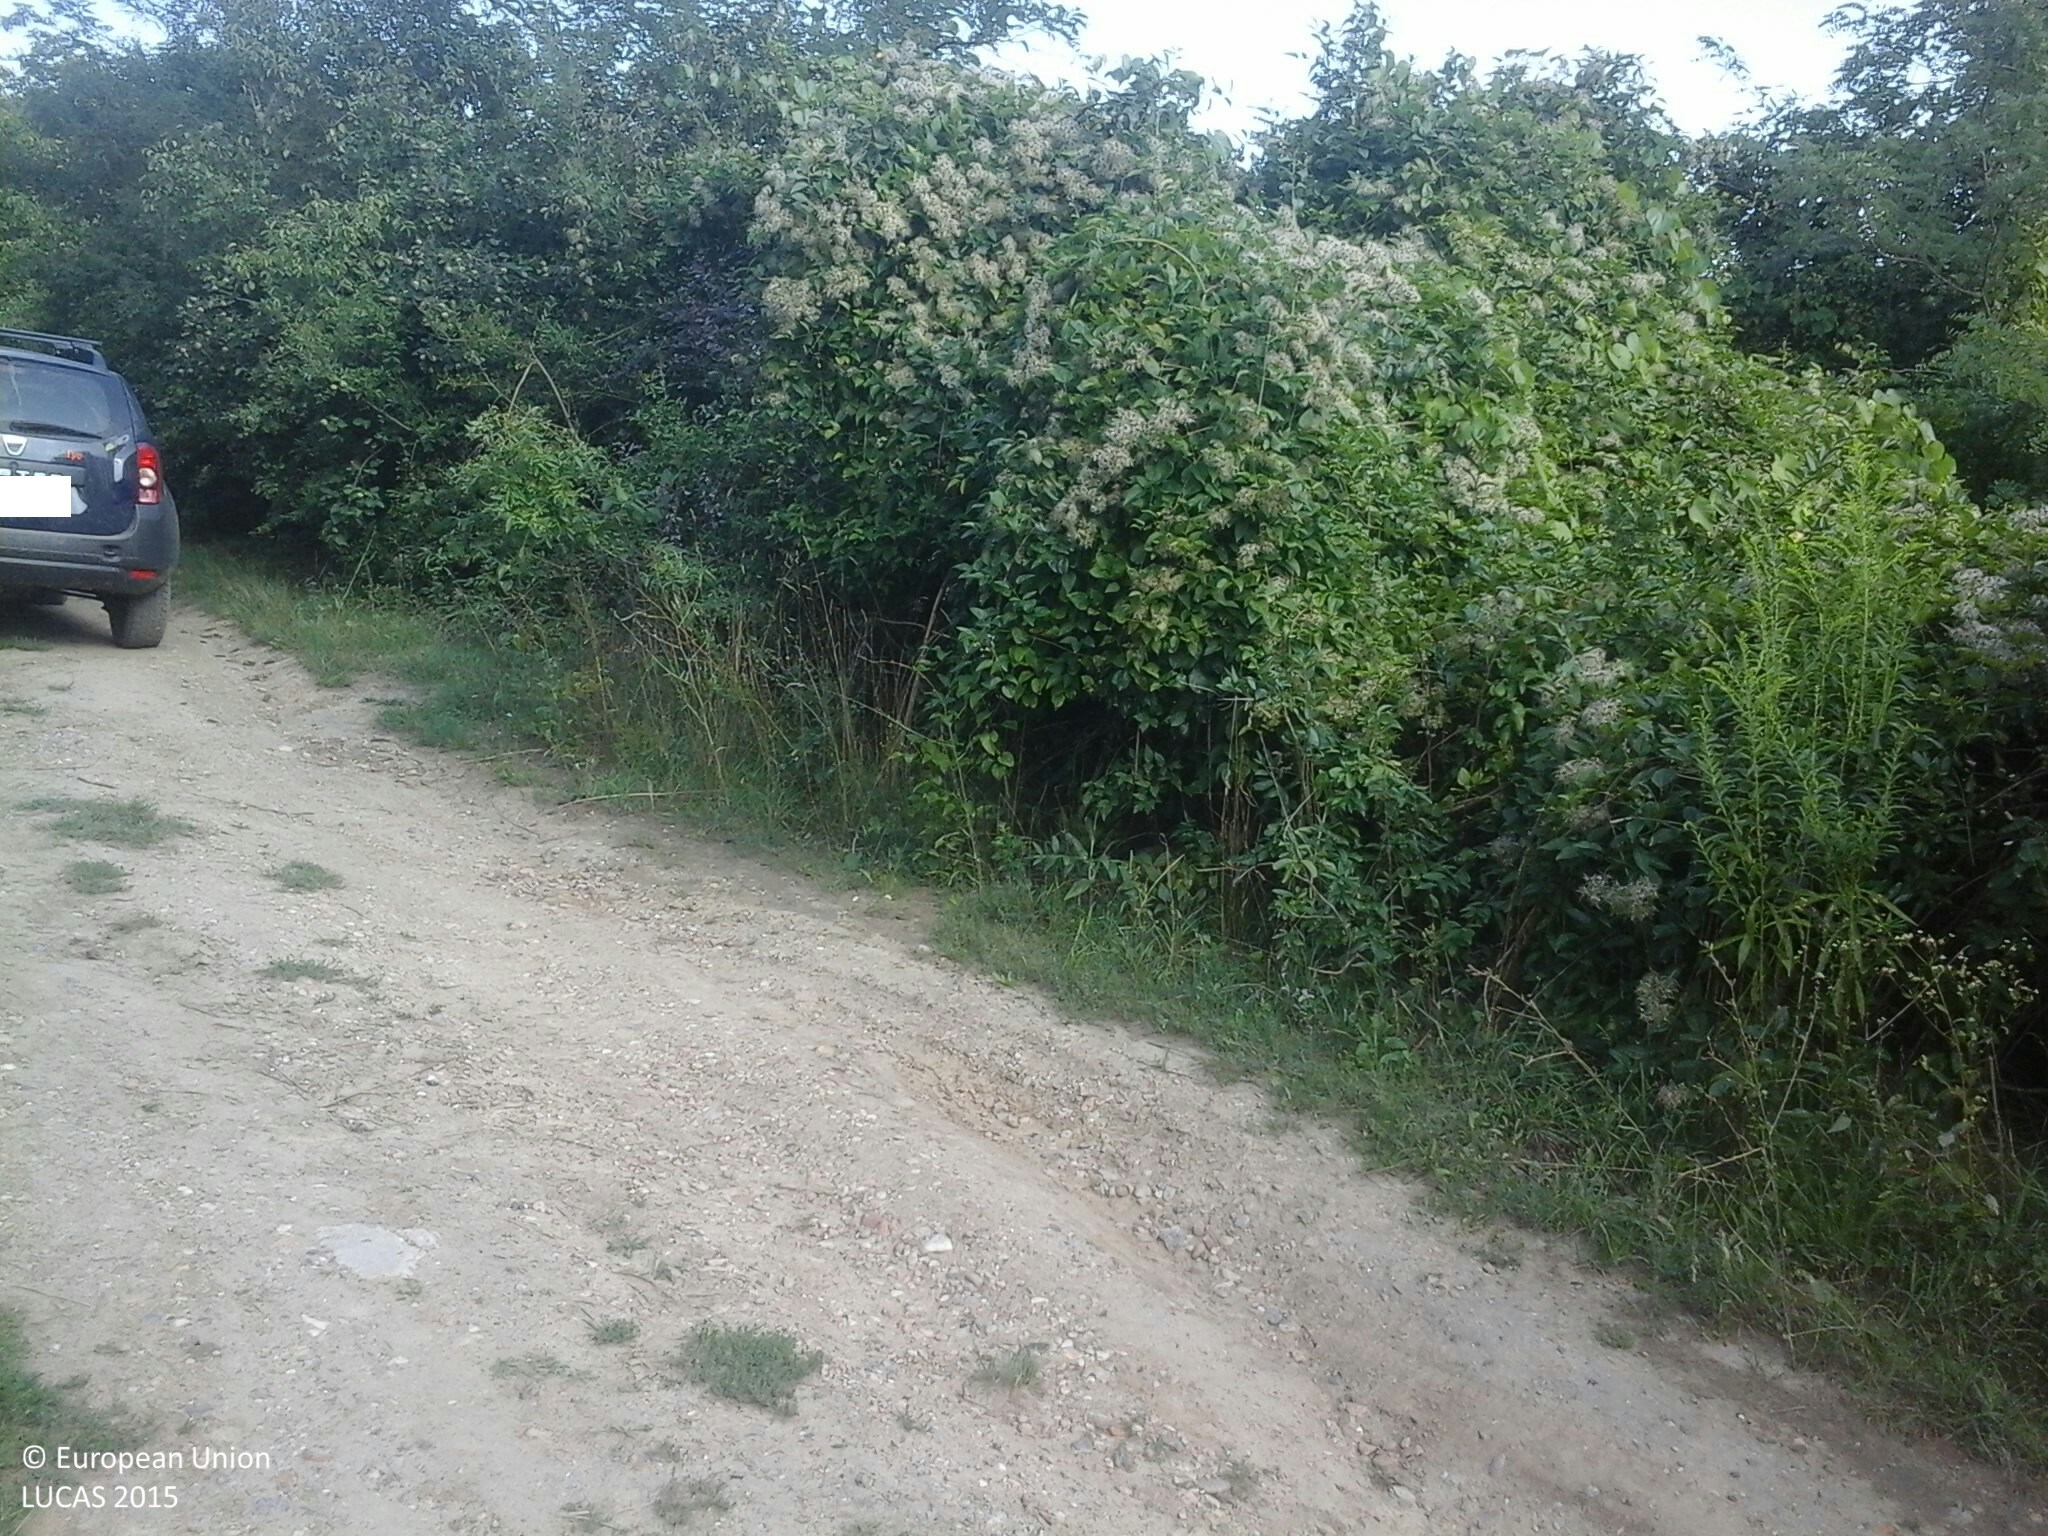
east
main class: Grassland
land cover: Spontaneously vegetated surfaces
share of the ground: > 75 %
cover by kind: herbaceous plants 100 %
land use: Residential
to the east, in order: Spontaneously vegetated surfaces; Artificial constructions in urban areas; Grass margins; Broadleaved woodland
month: August
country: HU
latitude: 48.0254
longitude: 19.3414
